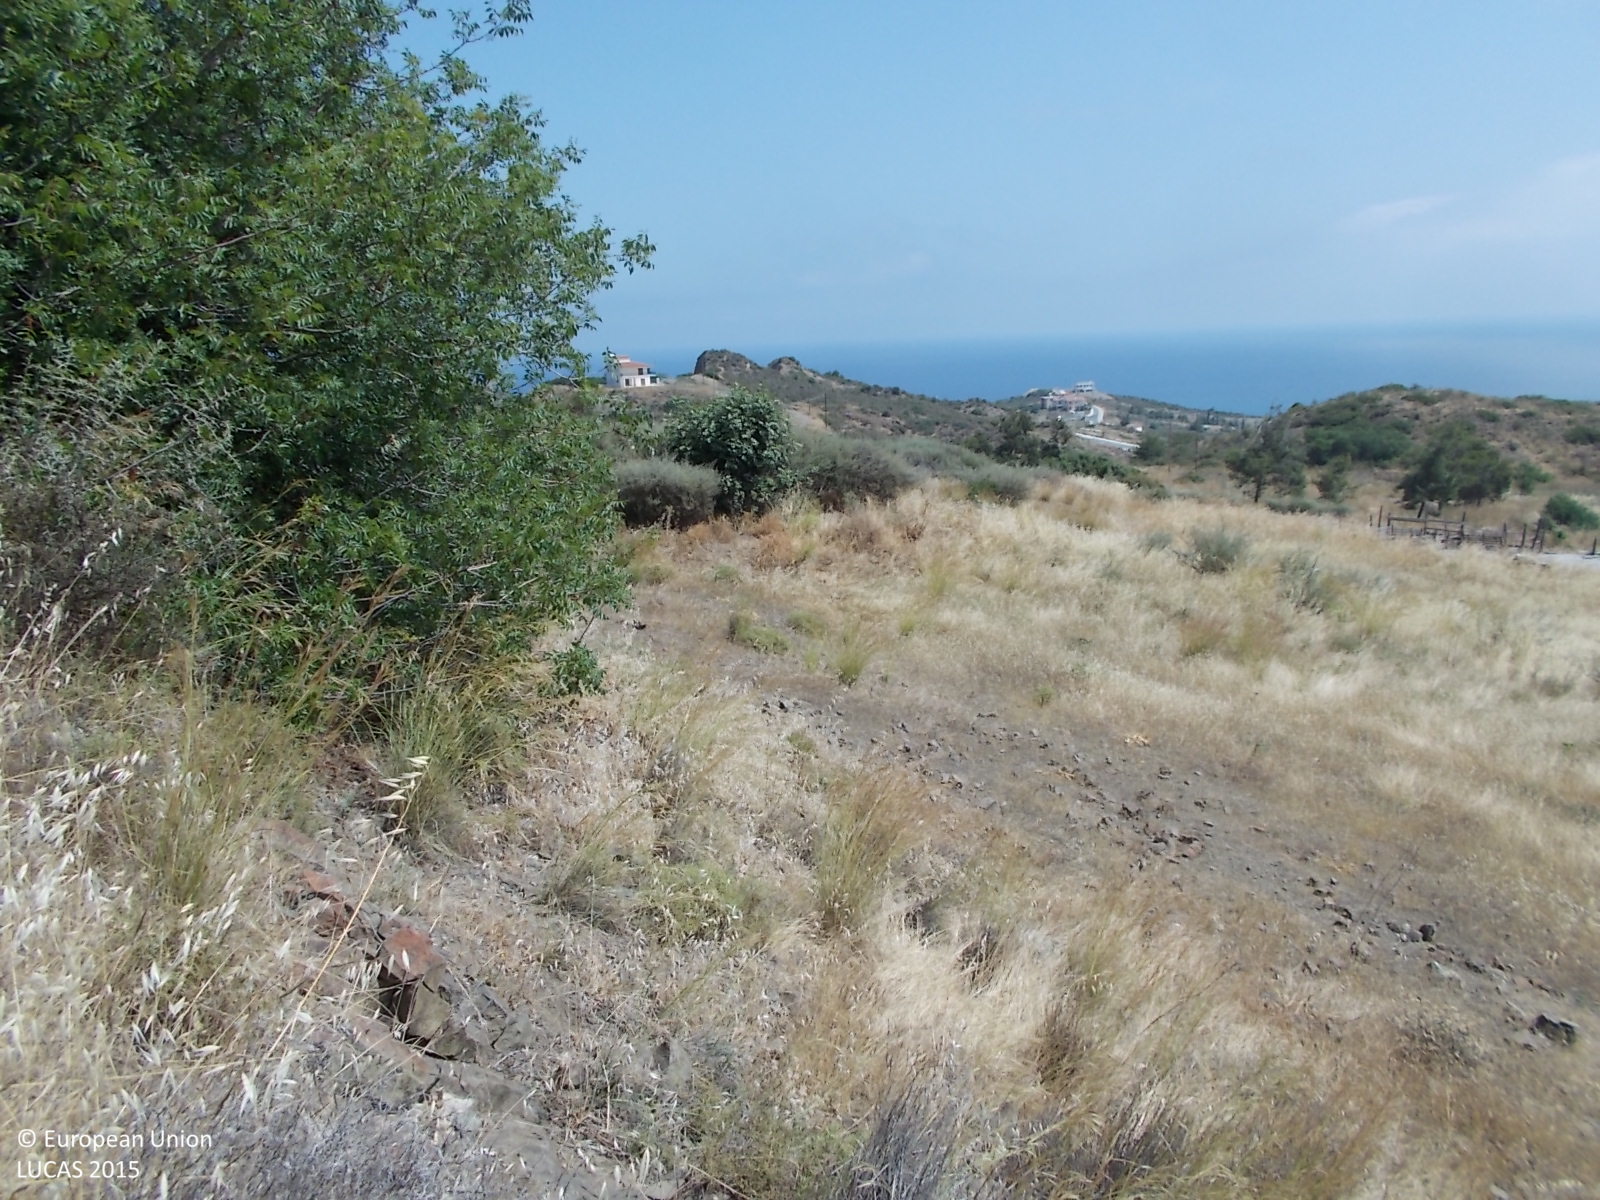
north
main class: Shrubland
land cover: Shrubland without tree cover
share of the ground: 25 - 50 %
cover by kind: herbaceous plants 55 %, shrubs 35 %, unconsolidated bare surface 10 %
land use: Semi-natural and natural areas not in use
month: May
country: CY
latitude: 35.1784
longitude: 32.6663
